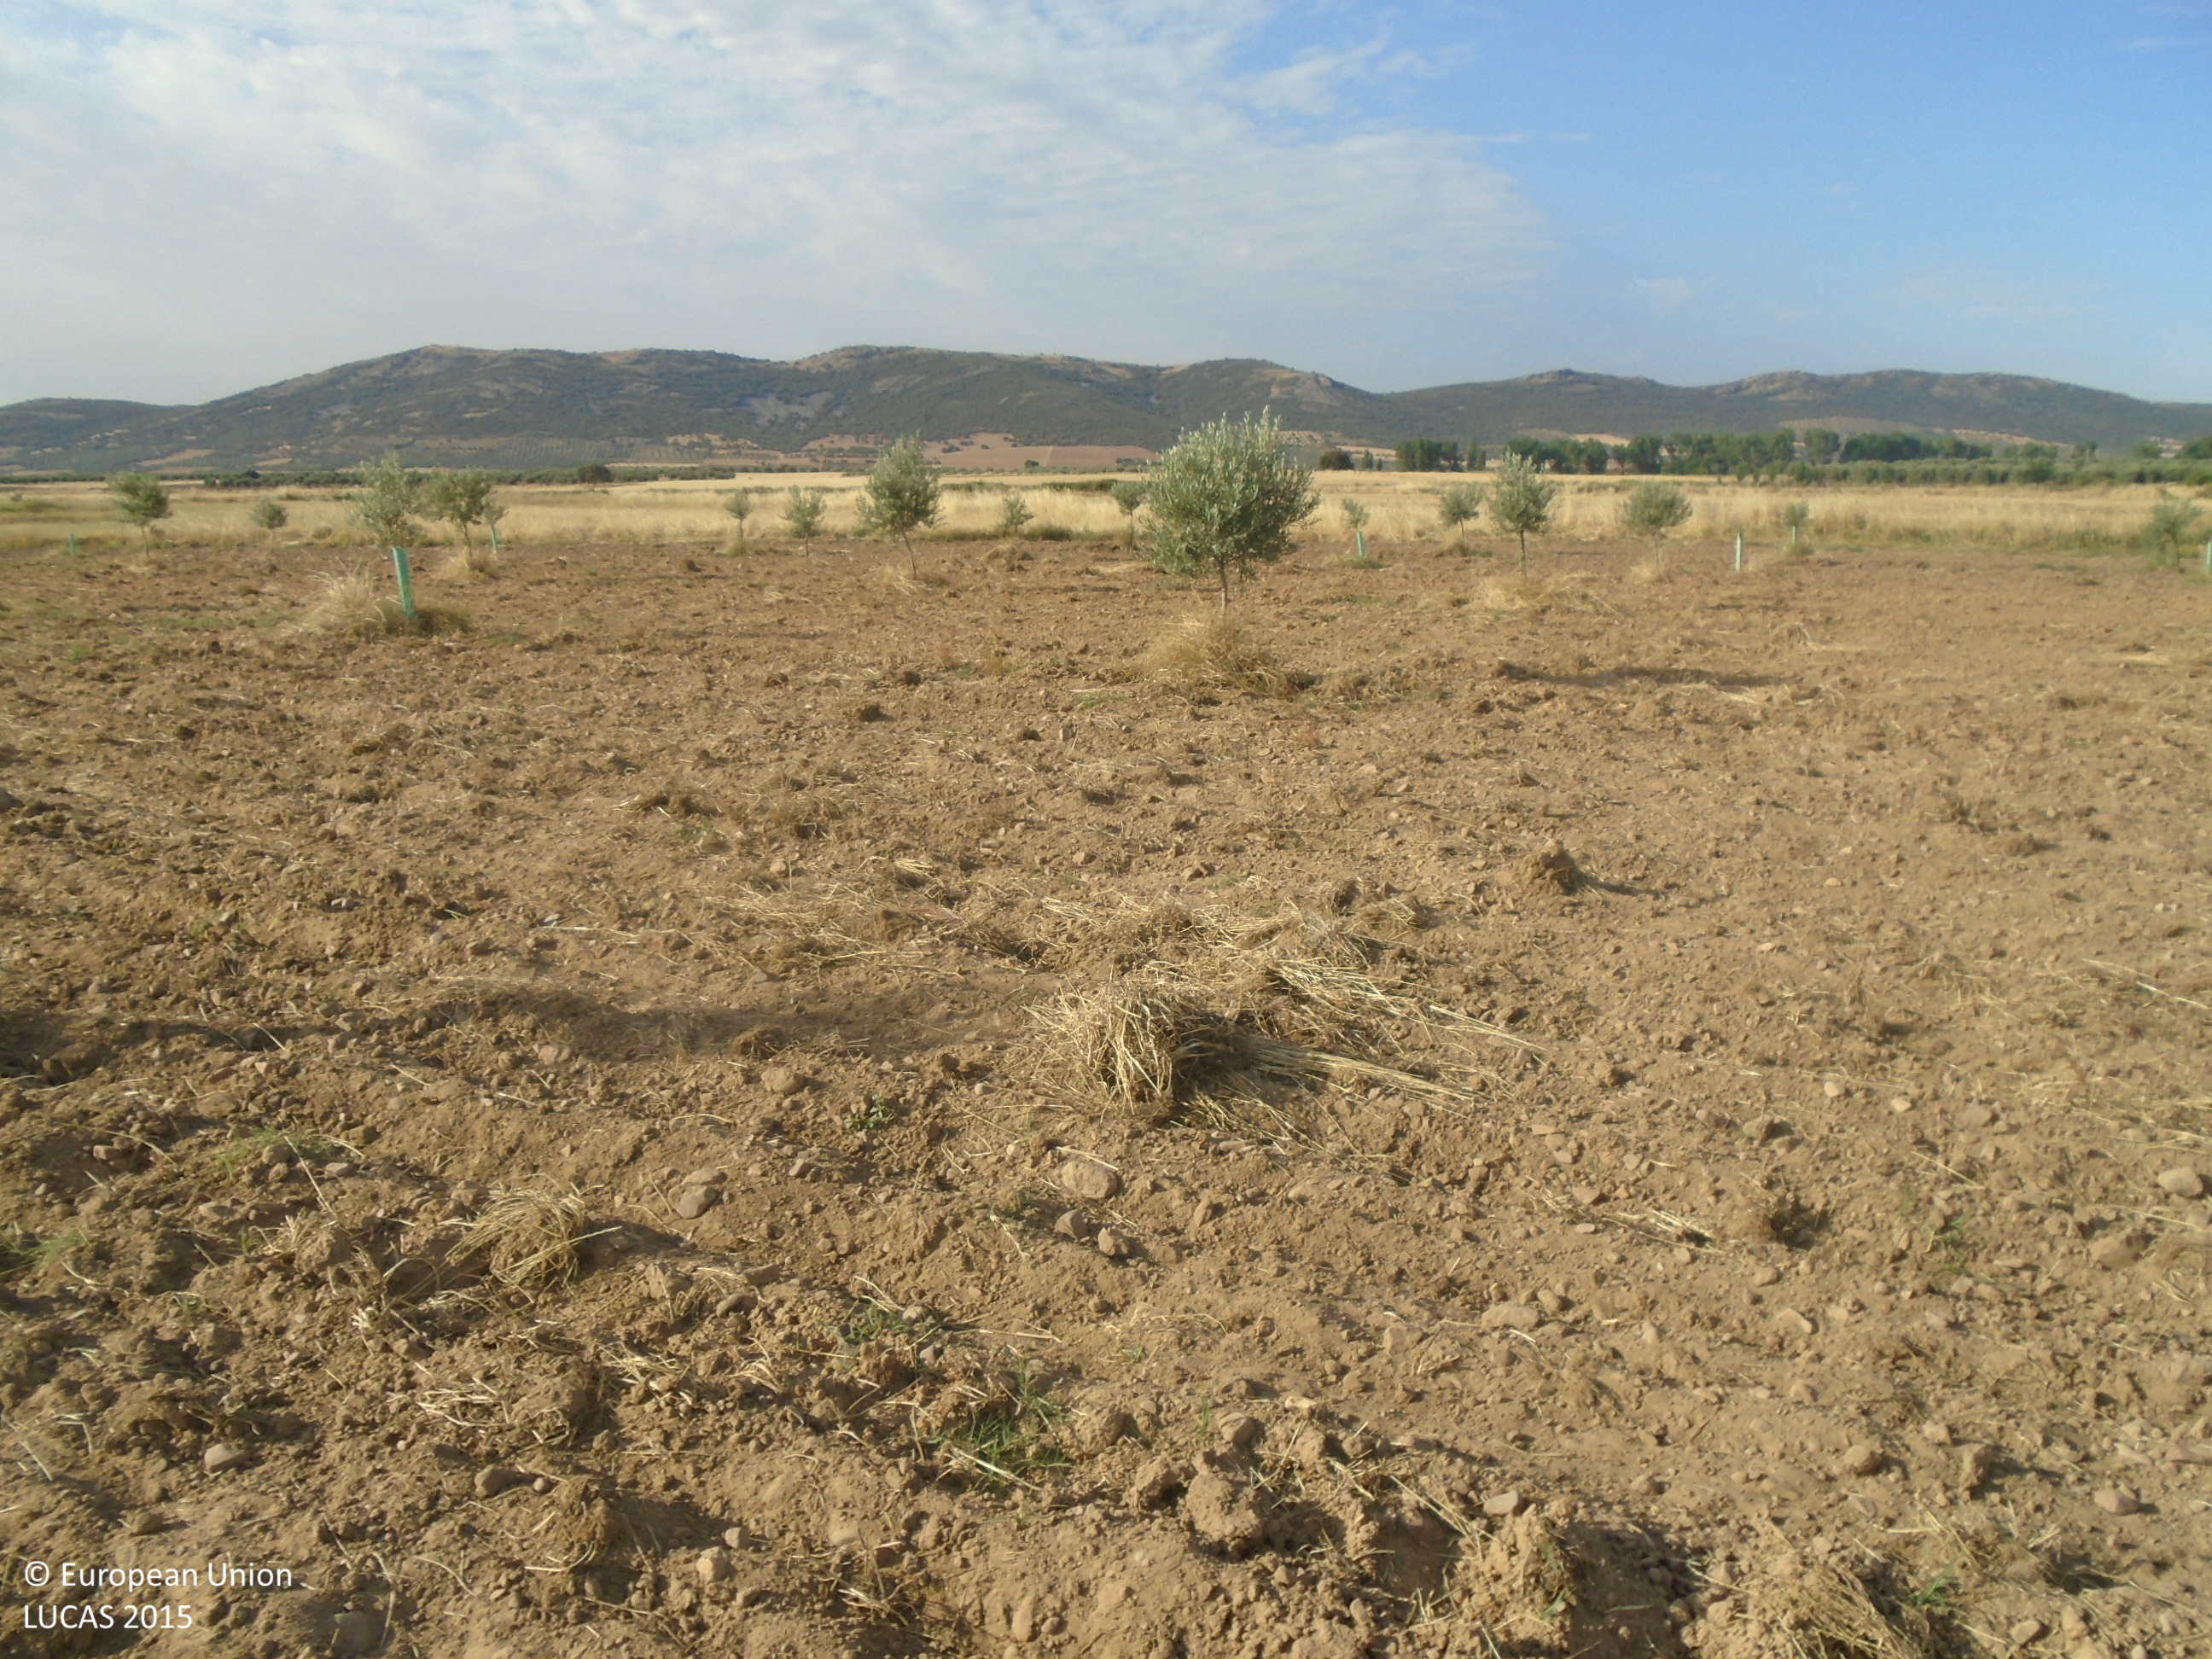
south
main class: Cropland
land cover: Olive groves
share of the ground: < 10 %
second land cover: Other bare soil
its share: > 75 %
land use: Agriculture (excluding fallow land and kitchen gardens)
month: July
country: ES
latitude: 39.1784
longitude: -4.0431
